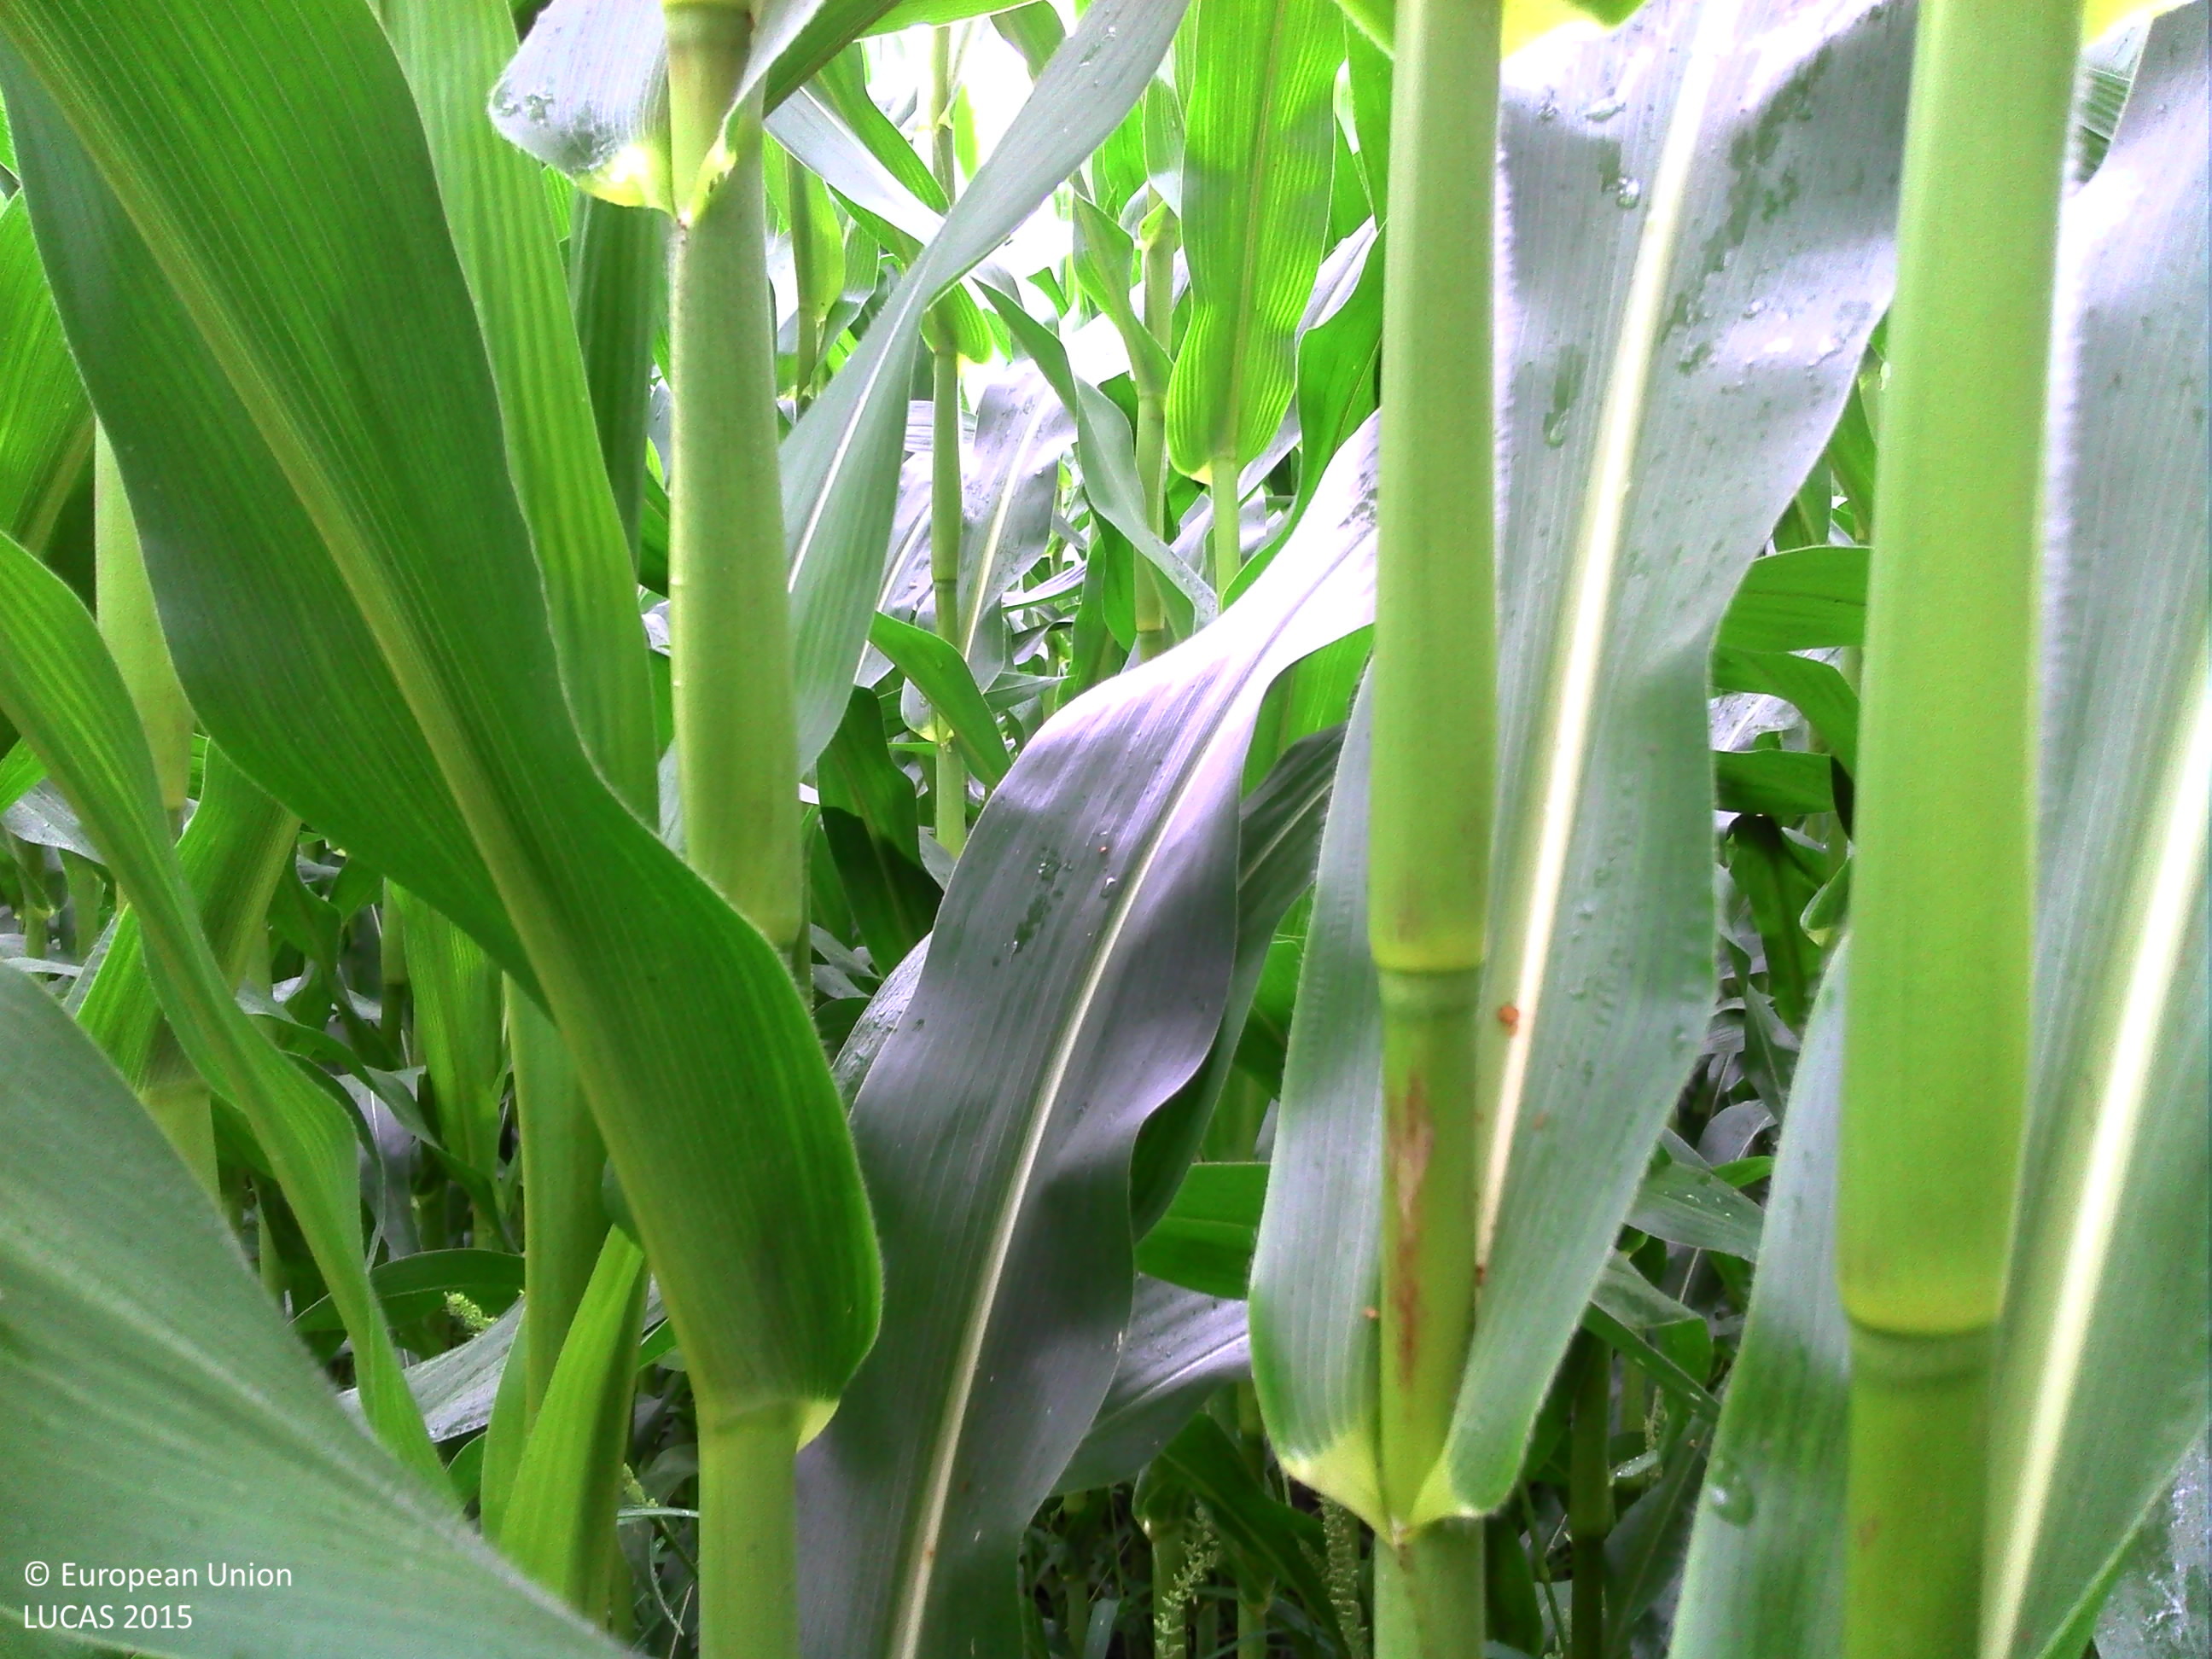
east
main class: Cropland
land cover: Maize
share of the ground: > 75 %
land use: Agriculture (excluding fallow land and kitchen gardens)
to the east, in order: Maize; Broadleaved woodland; Spontaneously vegetated surfaces; Broadleaved woodland
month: July
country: BE
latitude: 50.9044
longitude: 5.4618
